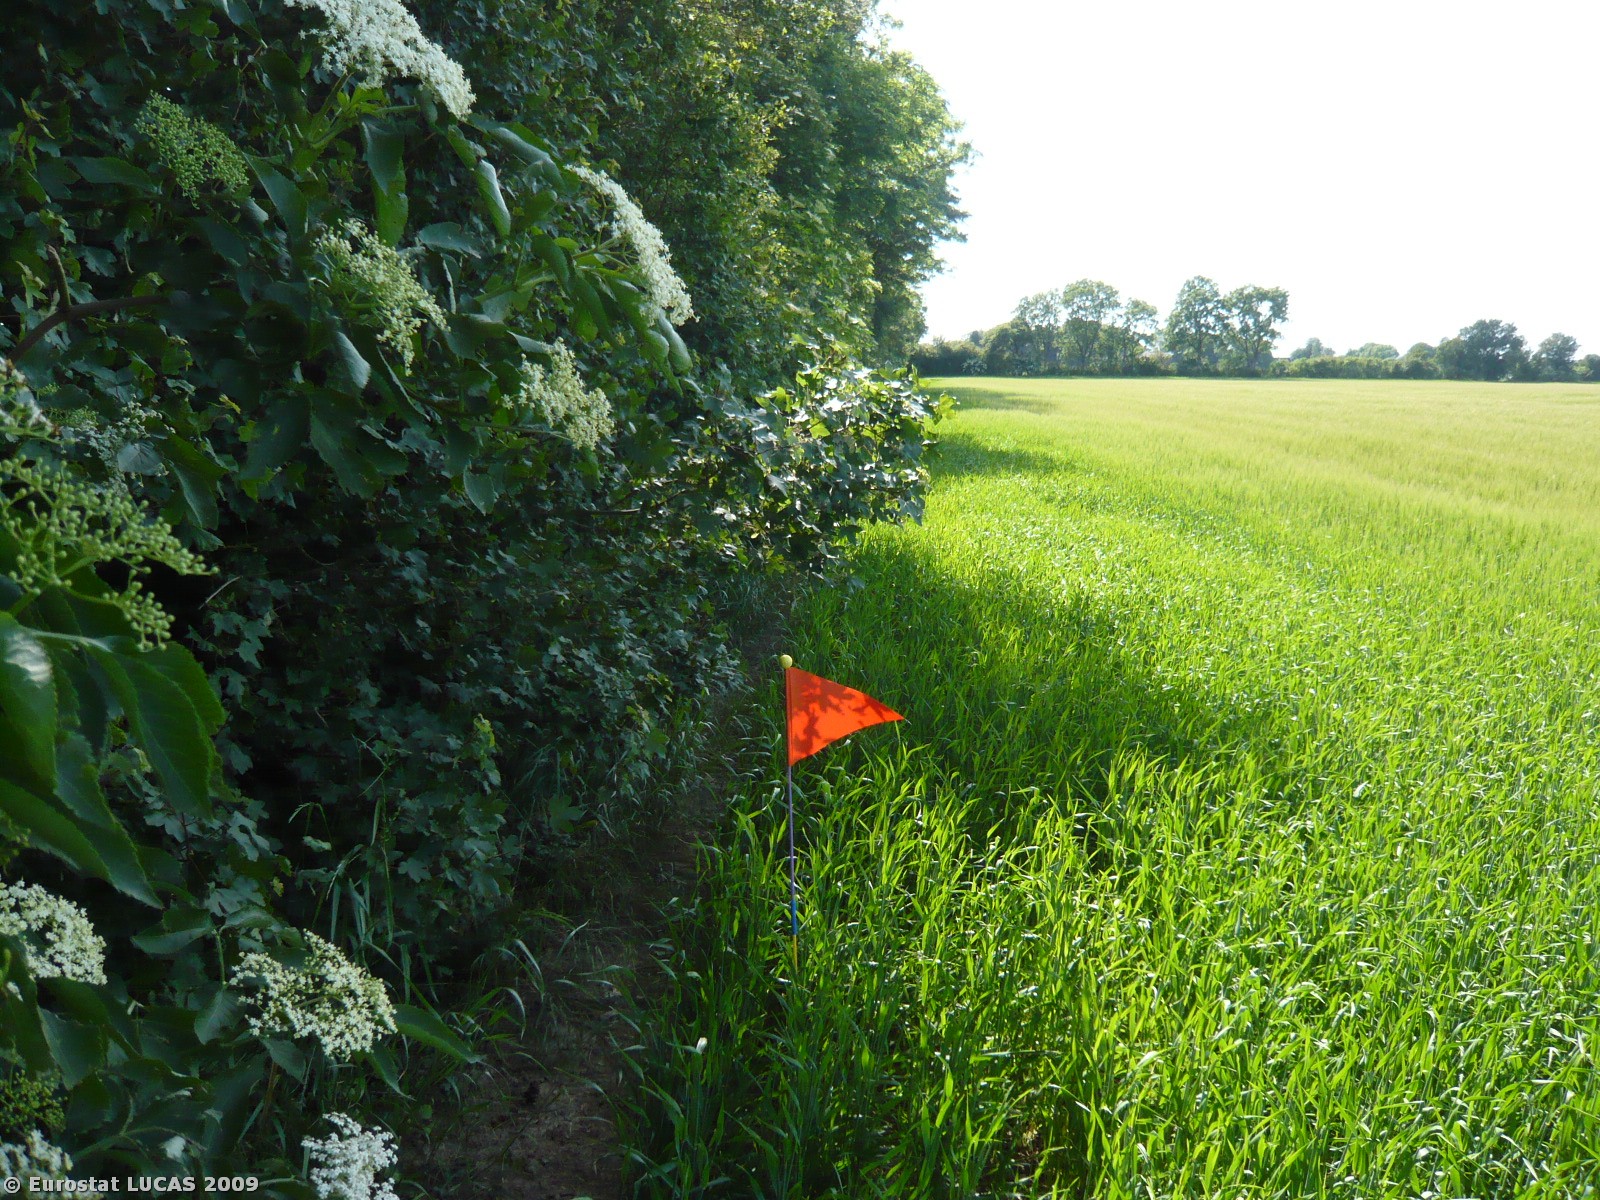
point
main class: Cropland
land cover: Barley
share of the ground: > 75 %
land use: Agriculture (excluding fallow land and kitchen gardens)
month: June
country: DK
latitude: 54.7791
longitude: 11.2896
